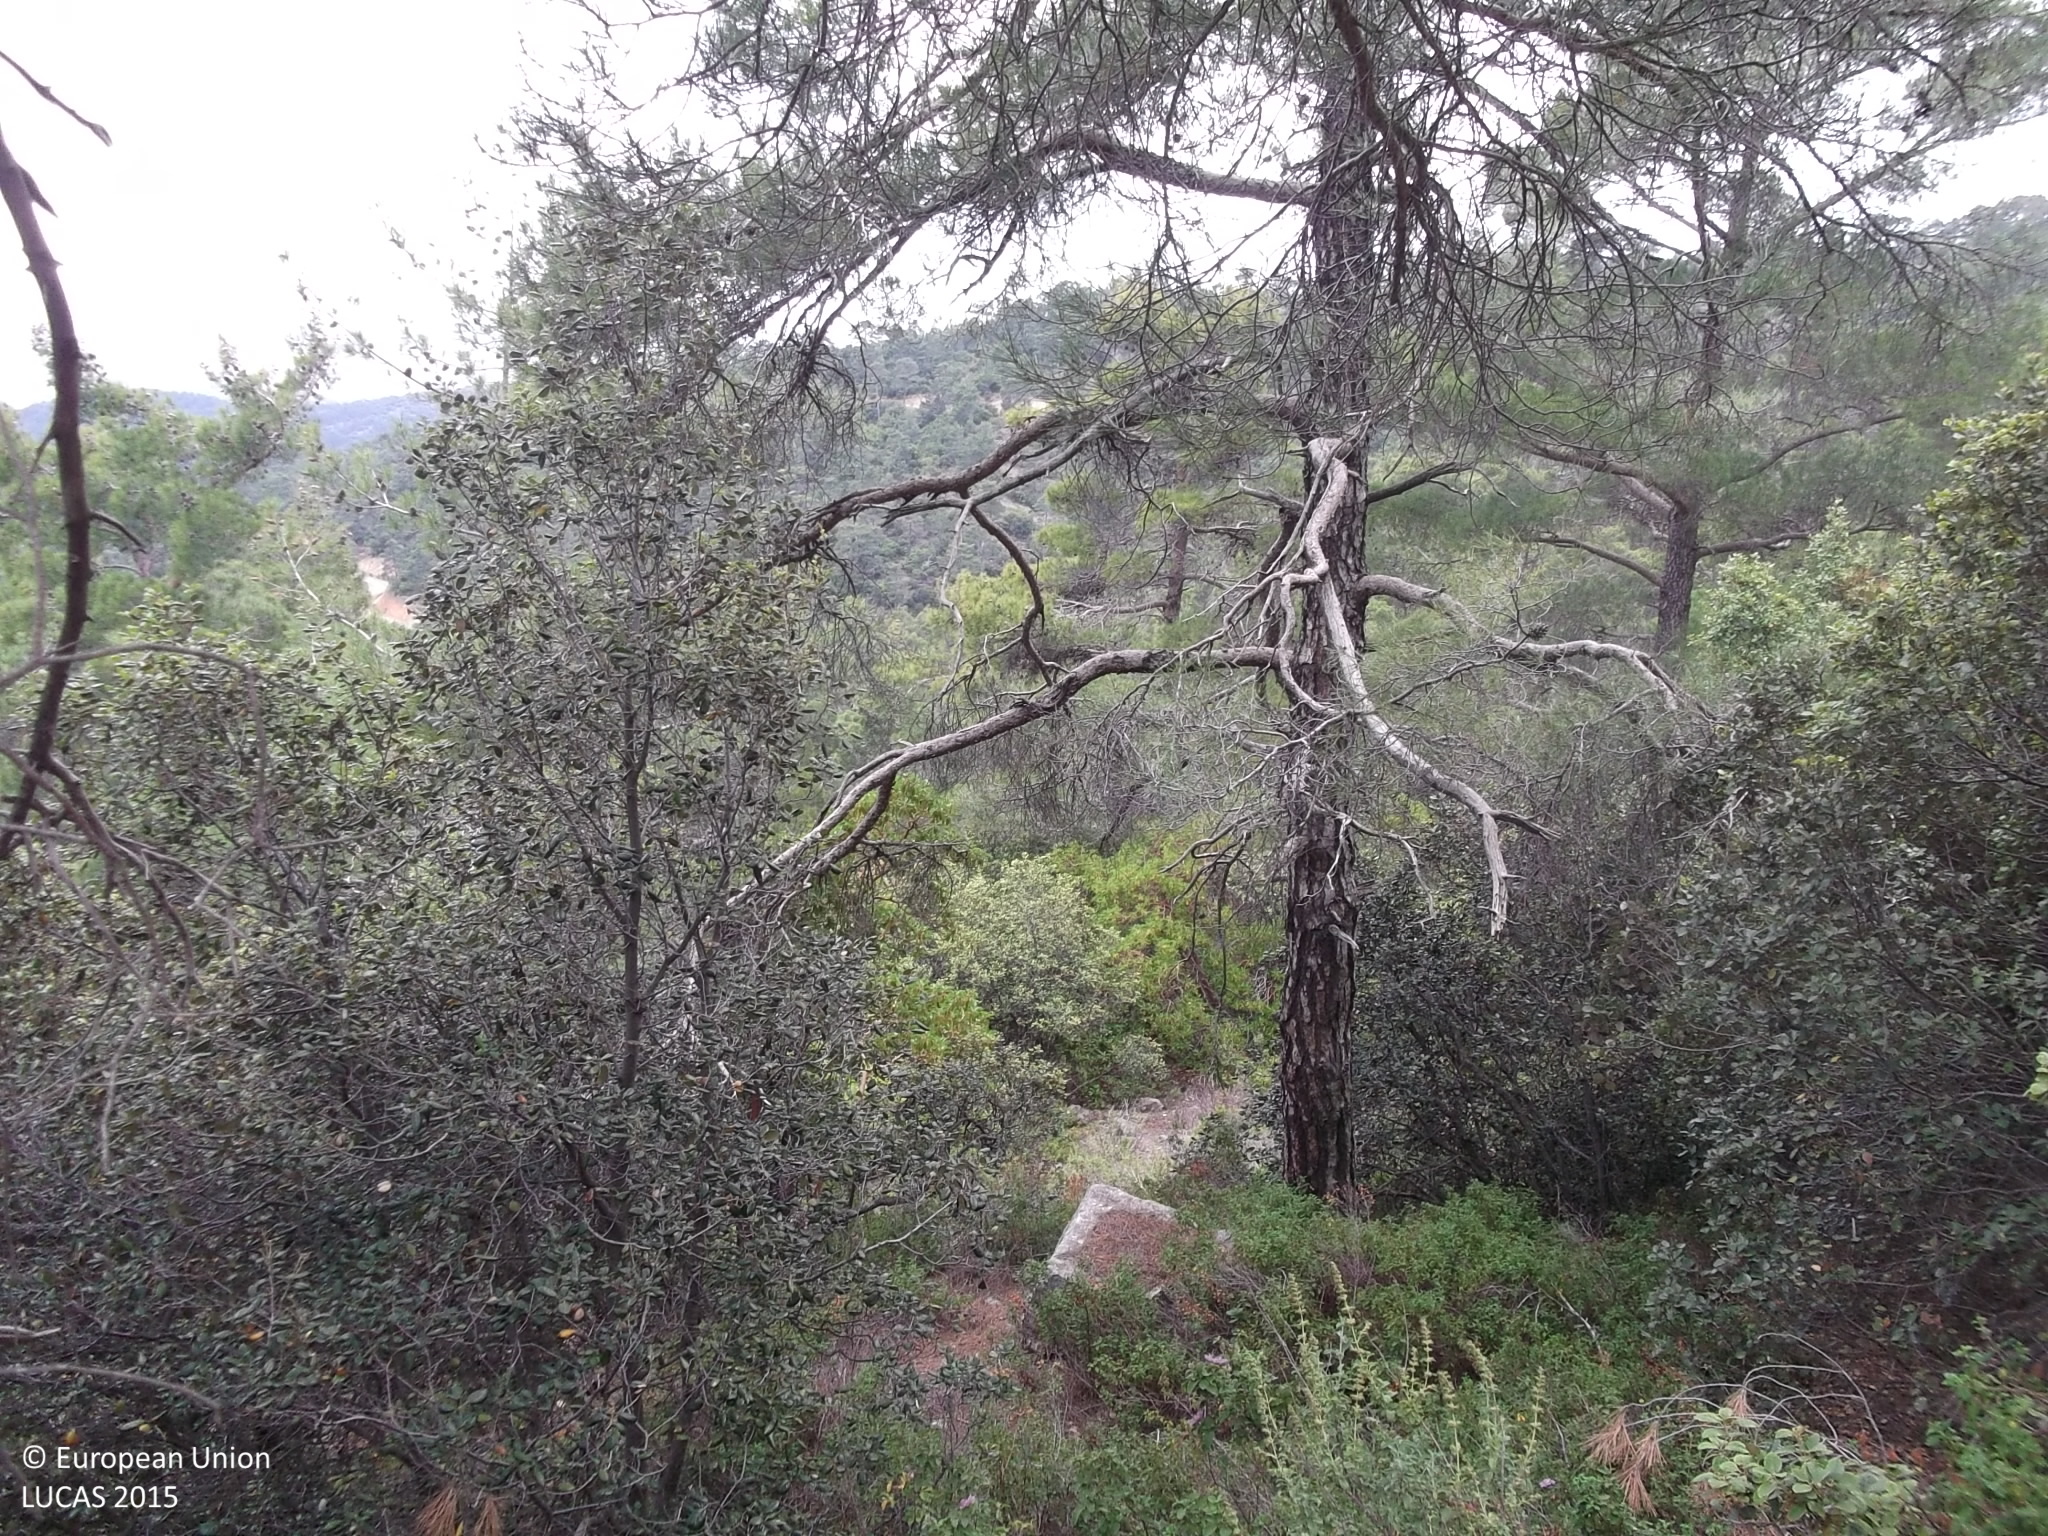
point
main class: Woodland
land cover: Pine dominated mixed woodland
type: coniferous forest of the mediterranean region
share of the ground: > 75 %
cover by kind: coniferous forest trees 60 %, broadleaved forest trees 25 %, shrubs 10 %, unconsolidated bare surface 5 %
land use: Forestry
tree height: > 5 m
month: June
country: CY
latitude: 34.8958
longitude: 32.8947
